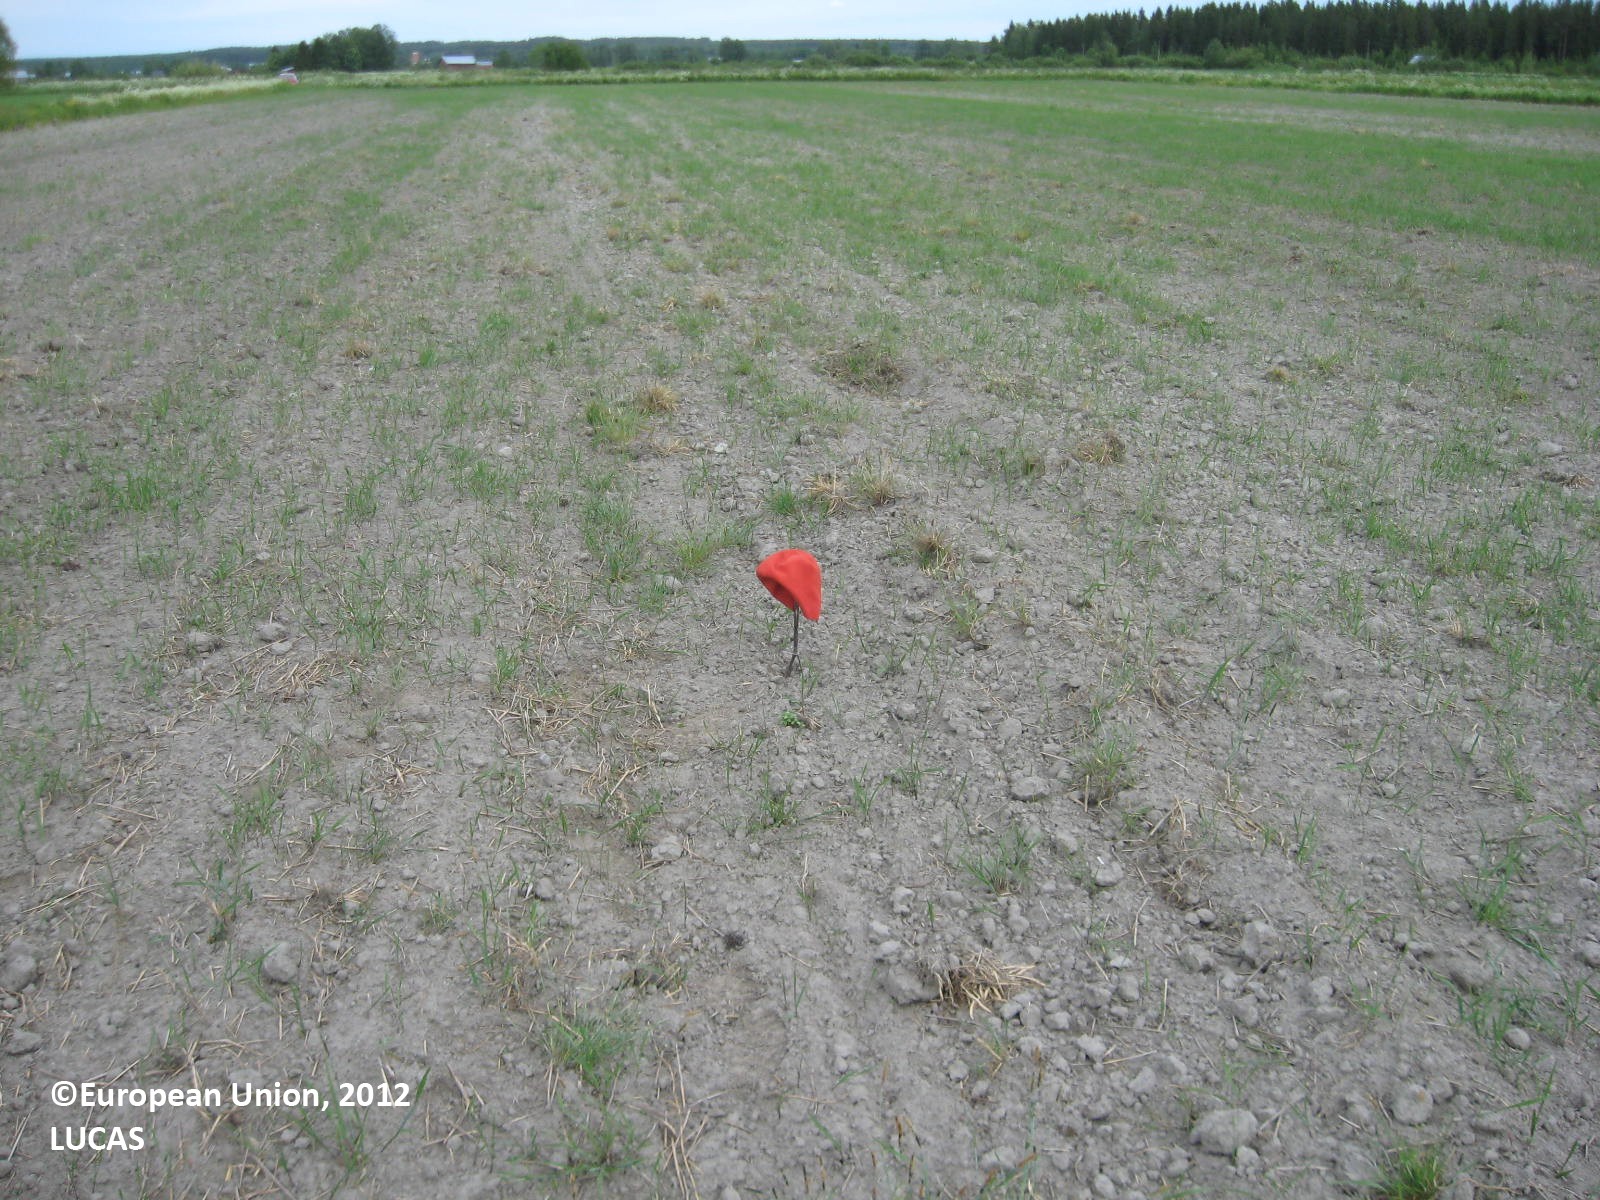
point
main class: Grassland
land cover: Spontaneously vegetated surfaces
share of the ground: 10 - 25 %
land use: Fallow land
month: June
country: FI
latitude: 62.6632
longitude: 21.4999
